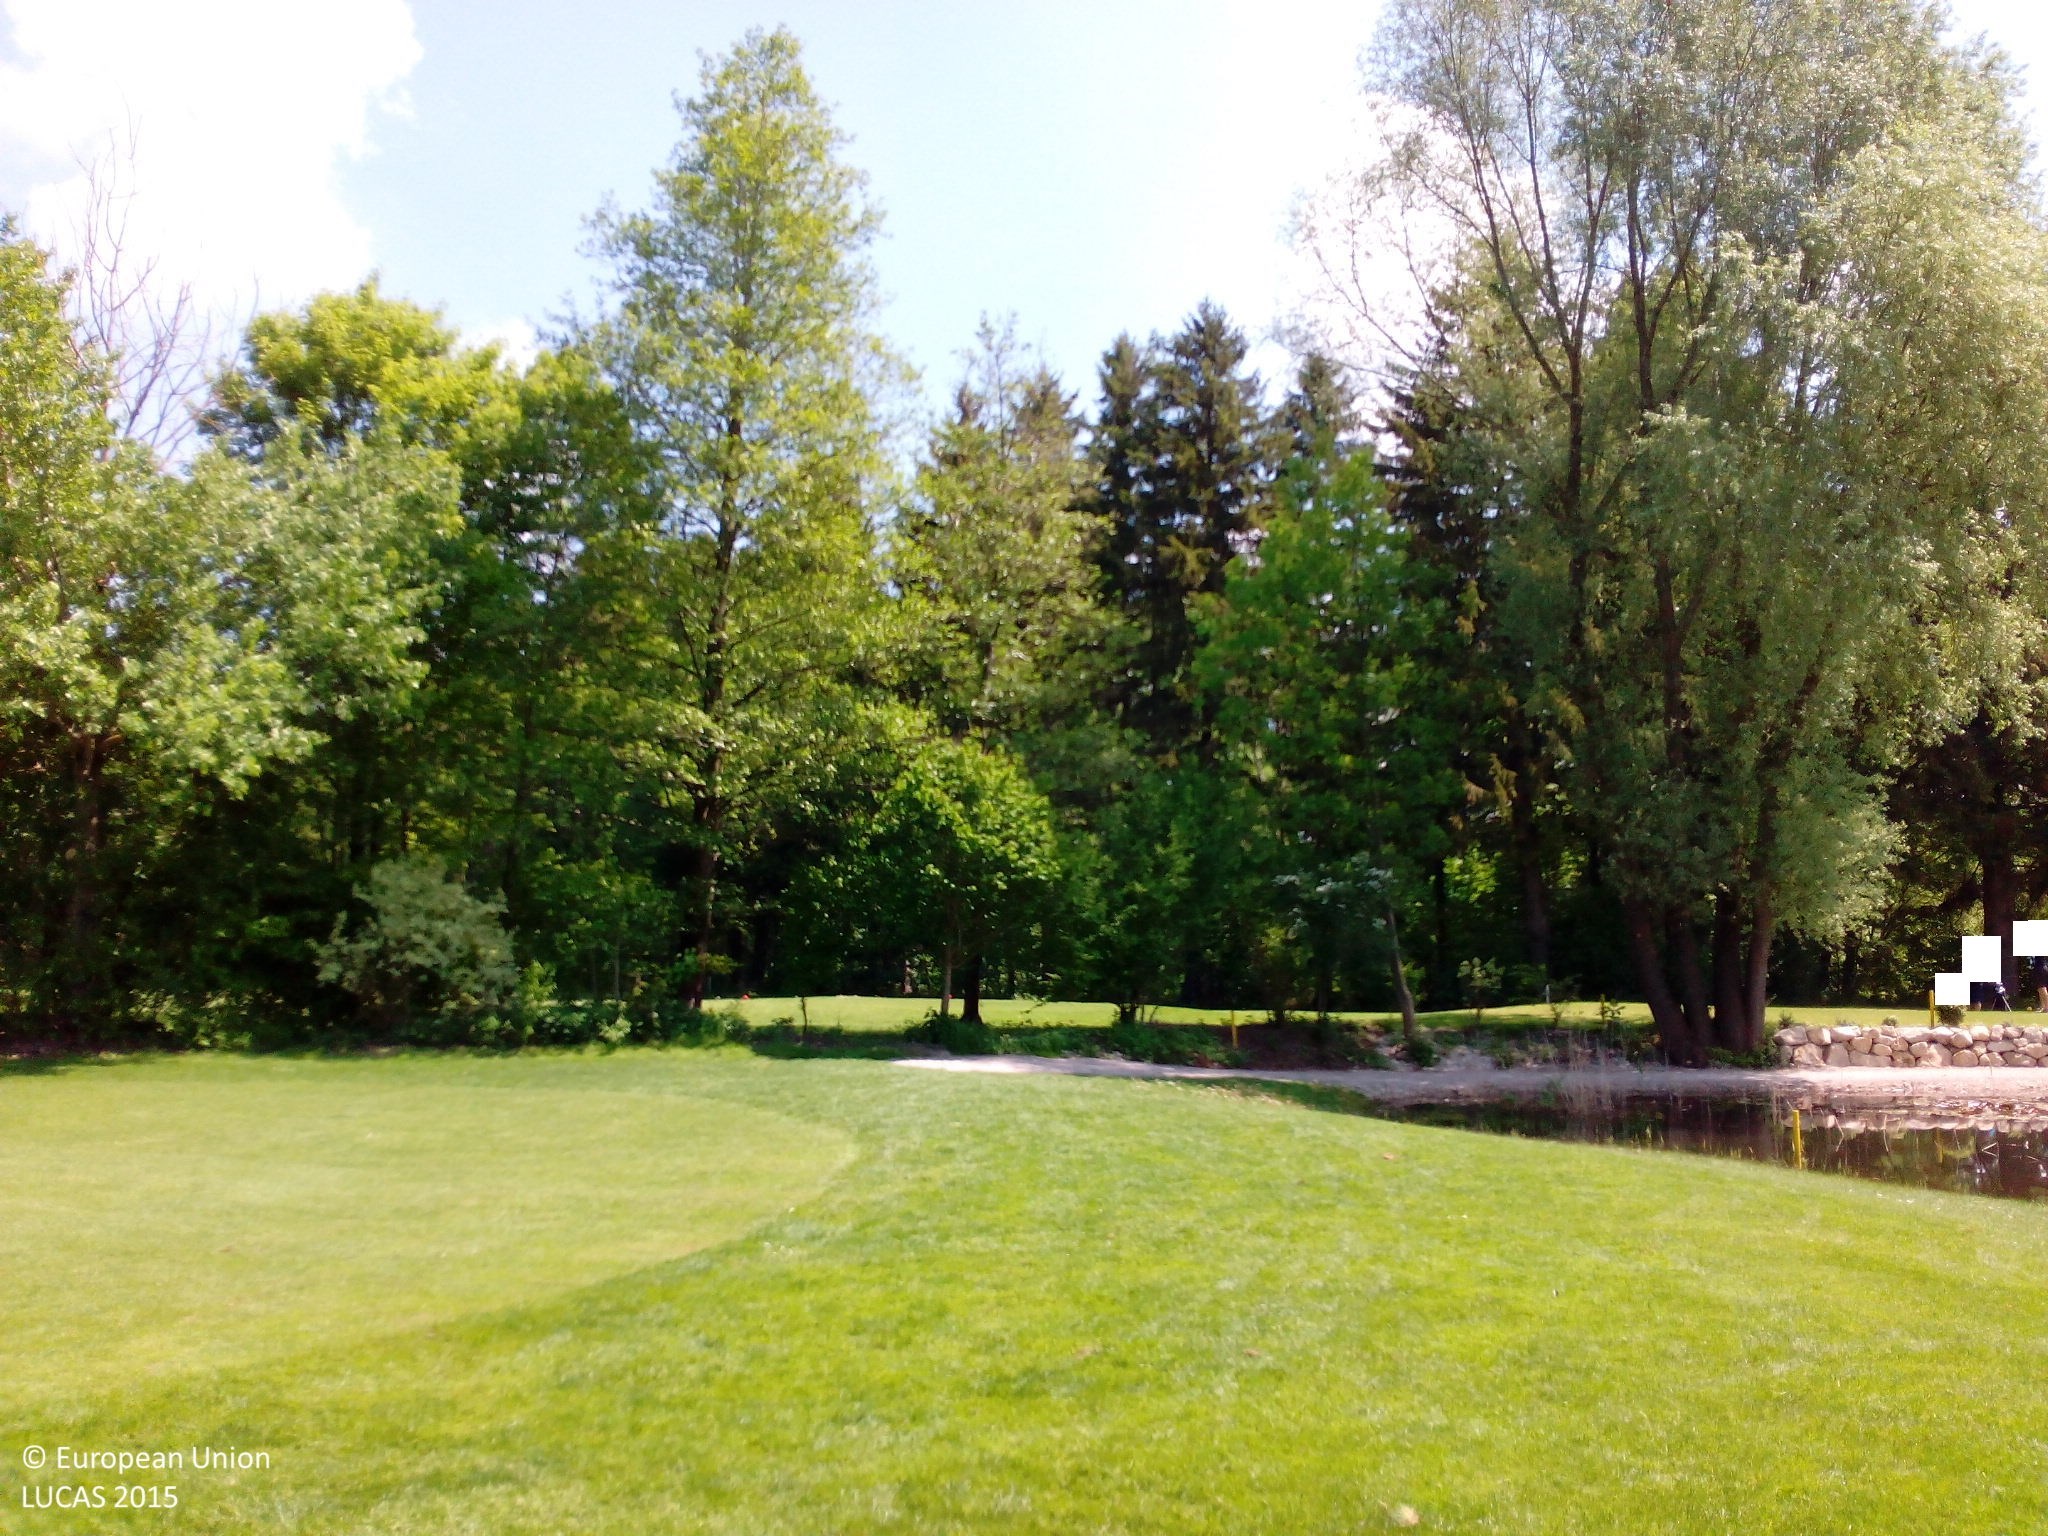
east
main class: Woodland
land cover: Broadleaved woodland
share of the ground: > 75 %
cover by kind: broadleaved forest trees 90 %, herbaceous plants 10 %
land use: Sport
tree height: > 5 m
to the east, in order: Broadleaved woodland; Grassland without tree/shrub cover; Broadleaved woodland; Grassland without tree/shrub cover; Tracks; Broadleaved woodland; Ditches and canals; Broadleaved woodland; Inland fresh running water; Broadleaved woodland; Grassland without tree/shrub cover; Broadleaved woodland; Grassland without tree/shrub cover
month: May
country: DE
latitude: 48.2145
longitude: 11.4123
